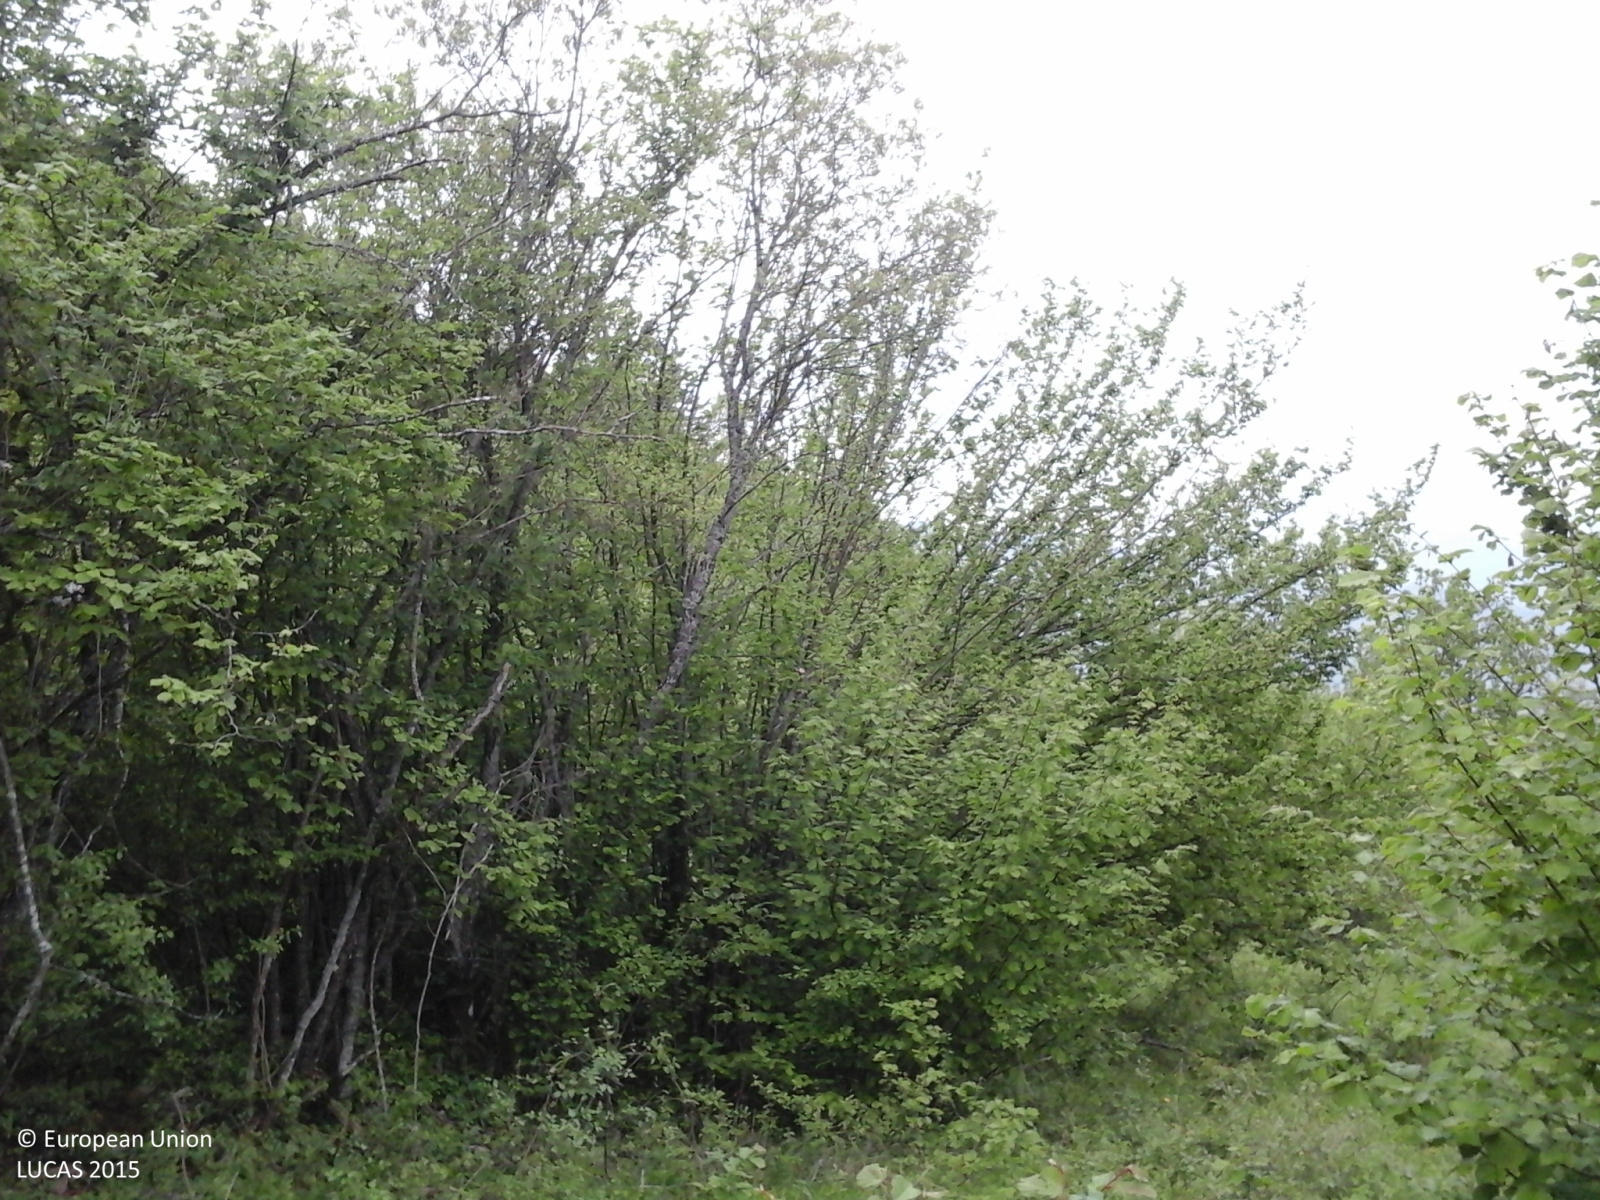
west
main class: Woodland
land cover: Broadleaved woodland
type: thermophilous deciduous forest
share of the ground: > 75 %
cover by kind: broadleaved forest trees 80 %, shrubs 15 %, herbaceous plants 5 %
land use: Forestry
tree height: > 5 m
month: May
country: IT
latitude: 44.6915
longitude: 9.4082
